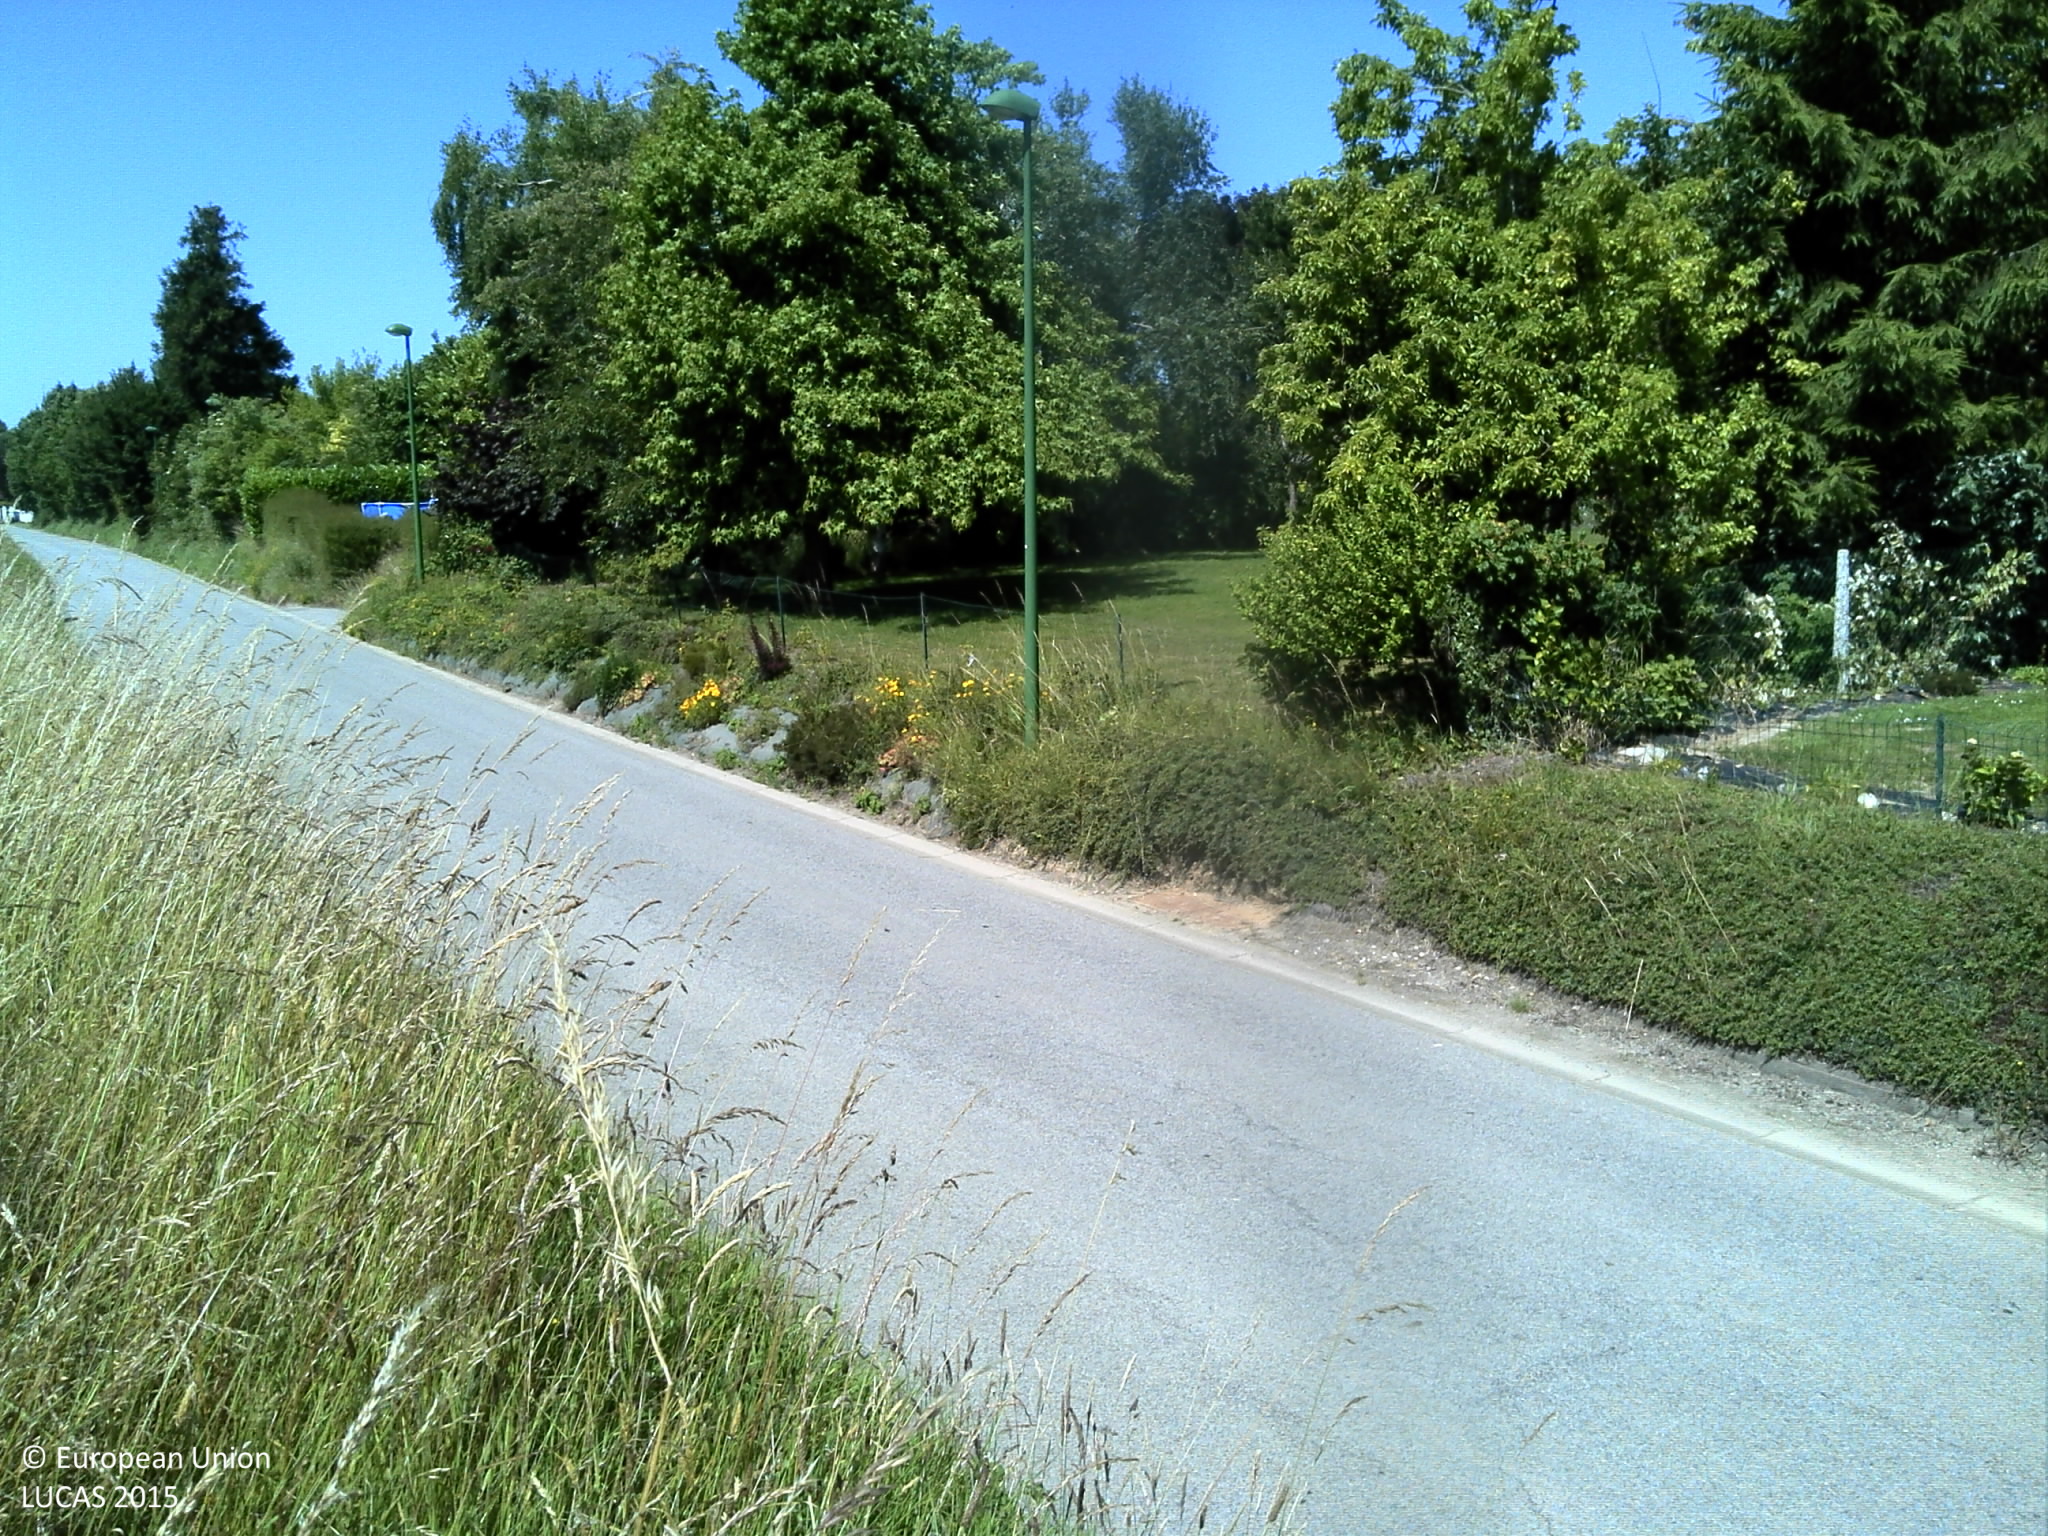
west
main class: Grassland
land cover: Grassland with sparse tree/shrub cover
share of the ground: > 75 %
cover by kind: herbaceous plants 95 %, broadleaved forest trees 5 %
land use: Agriculture (excluding fallow land and kitchen gardens)
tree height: < 5 m
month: June
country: FR
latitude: 49.8308
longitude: 1.0385
